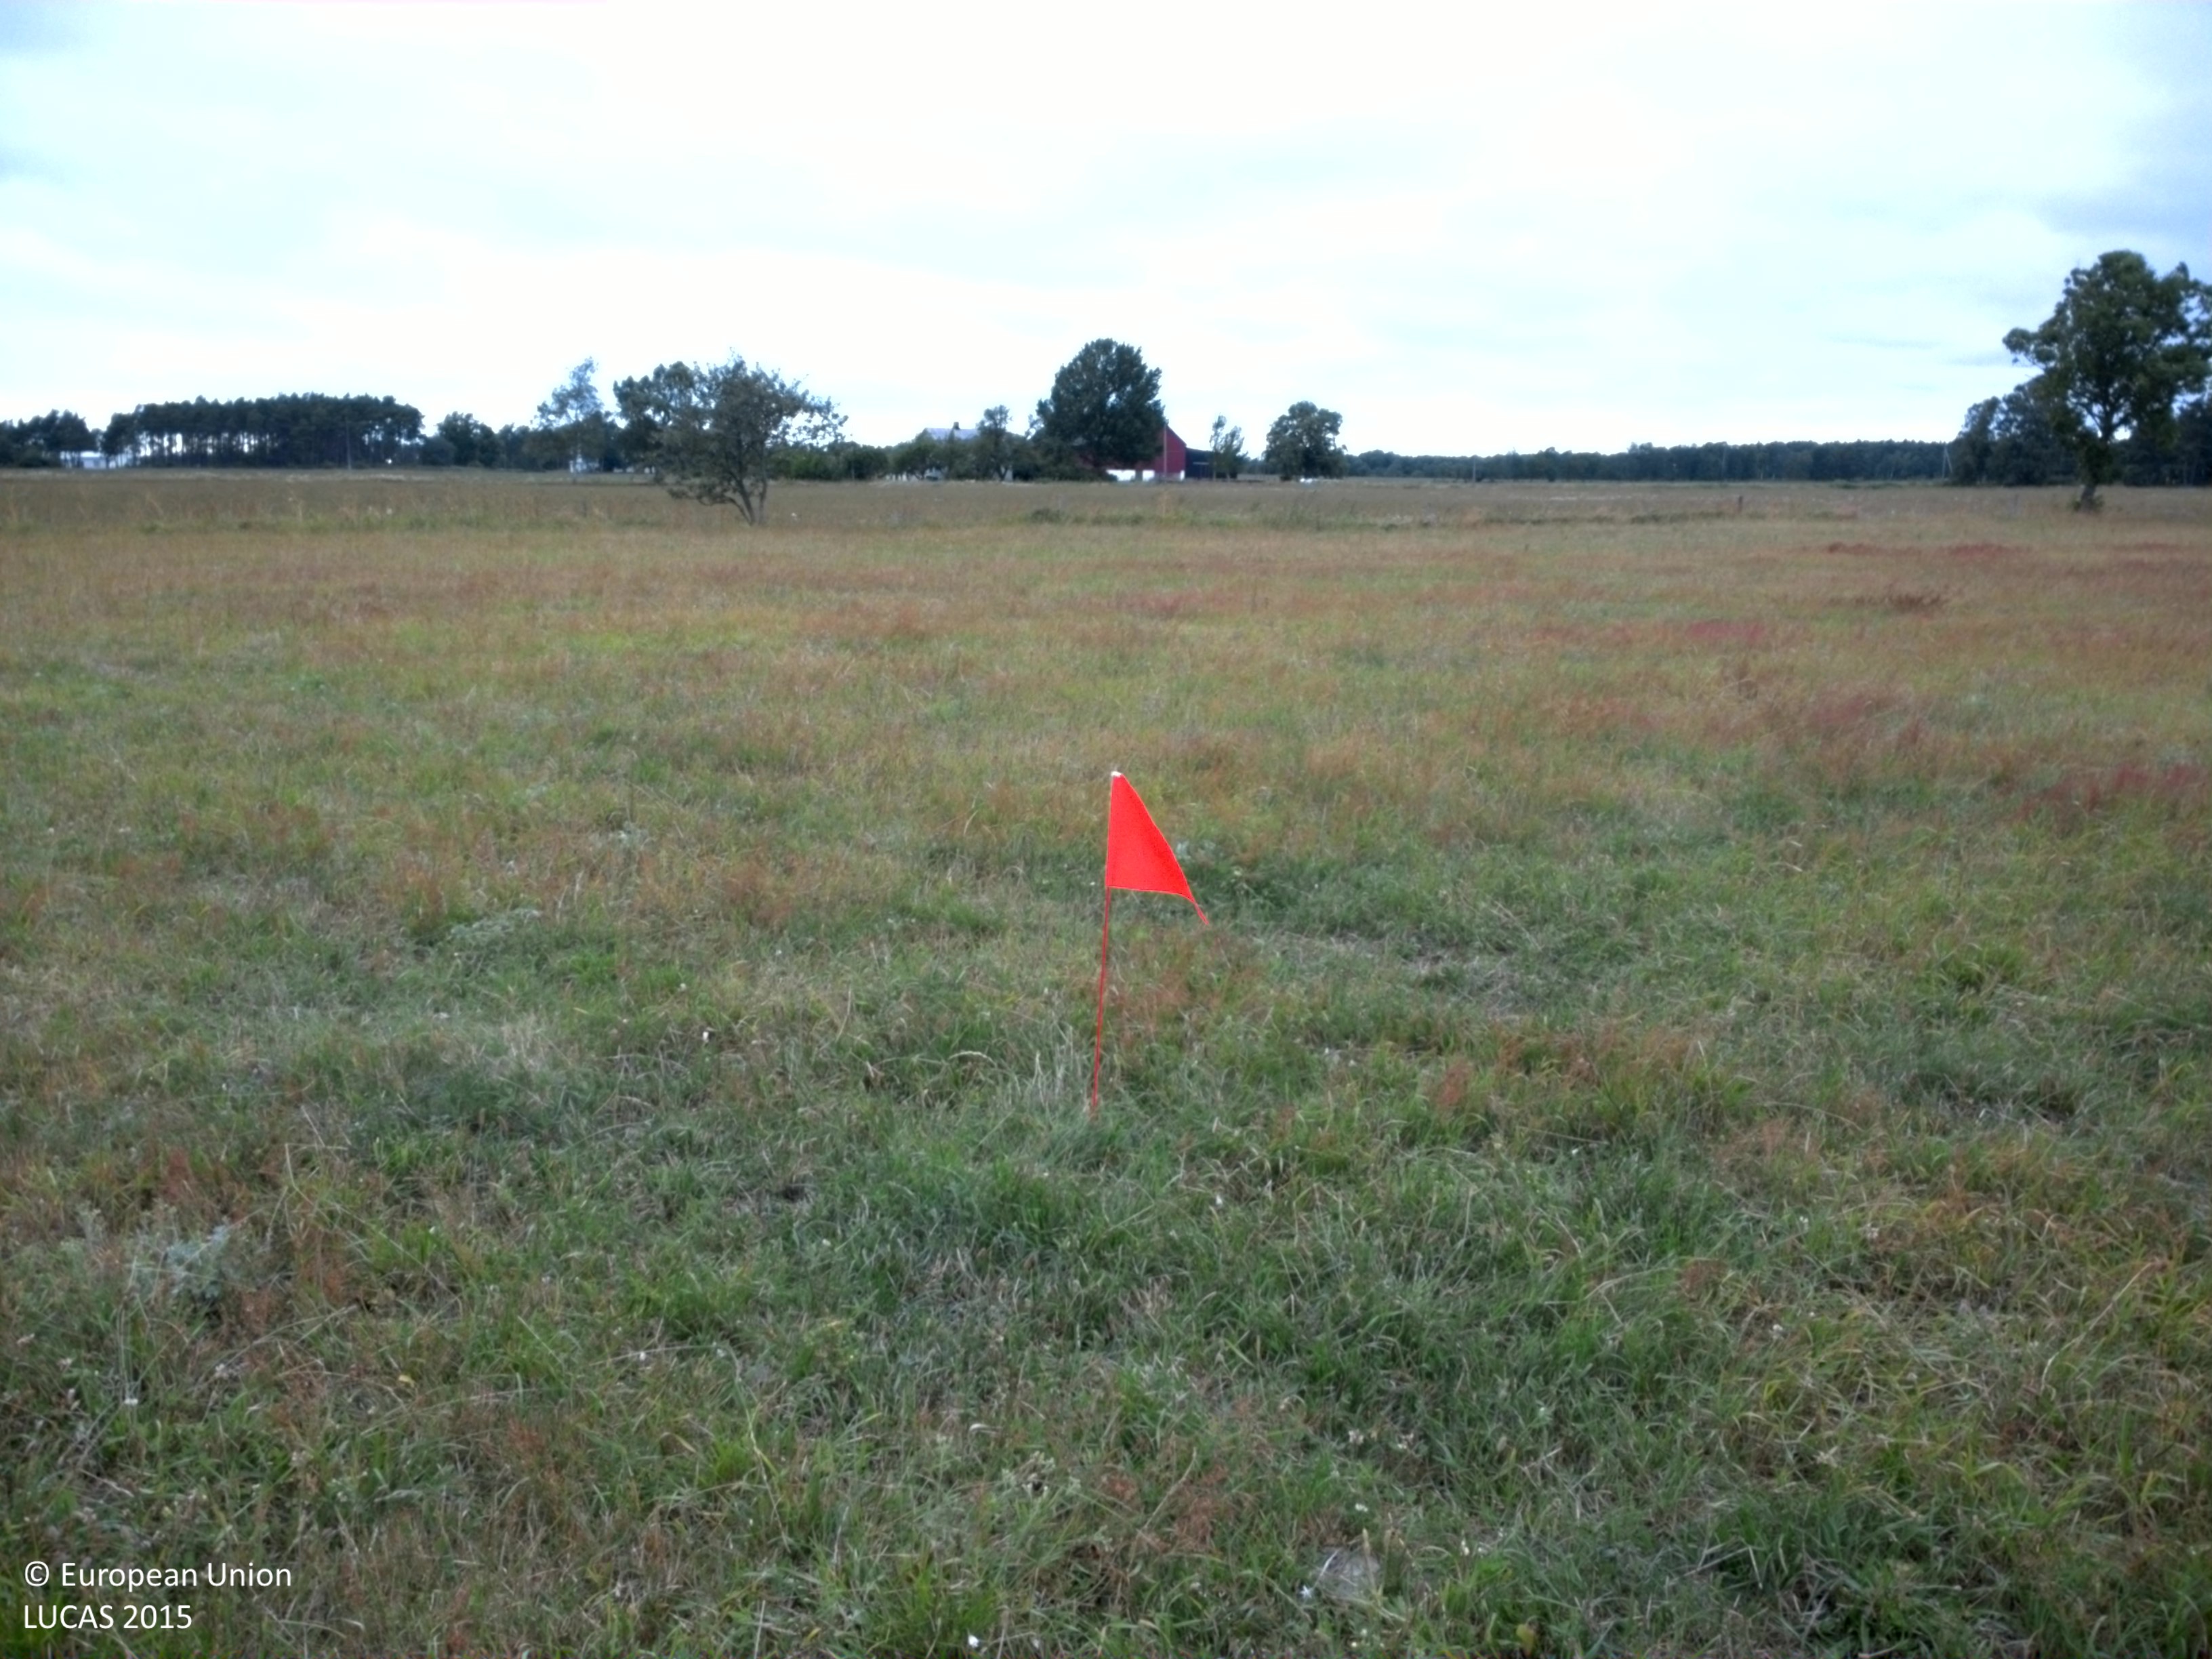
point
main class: Grassland
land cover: Grassland without tree/shrub cover
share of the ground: > 75 %
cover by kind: herbaceous plants 100 %
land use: Agriculture (excluding fallow land and kitchen gardens)
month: July
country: SE
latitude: 57.4470
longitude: 18.1549
